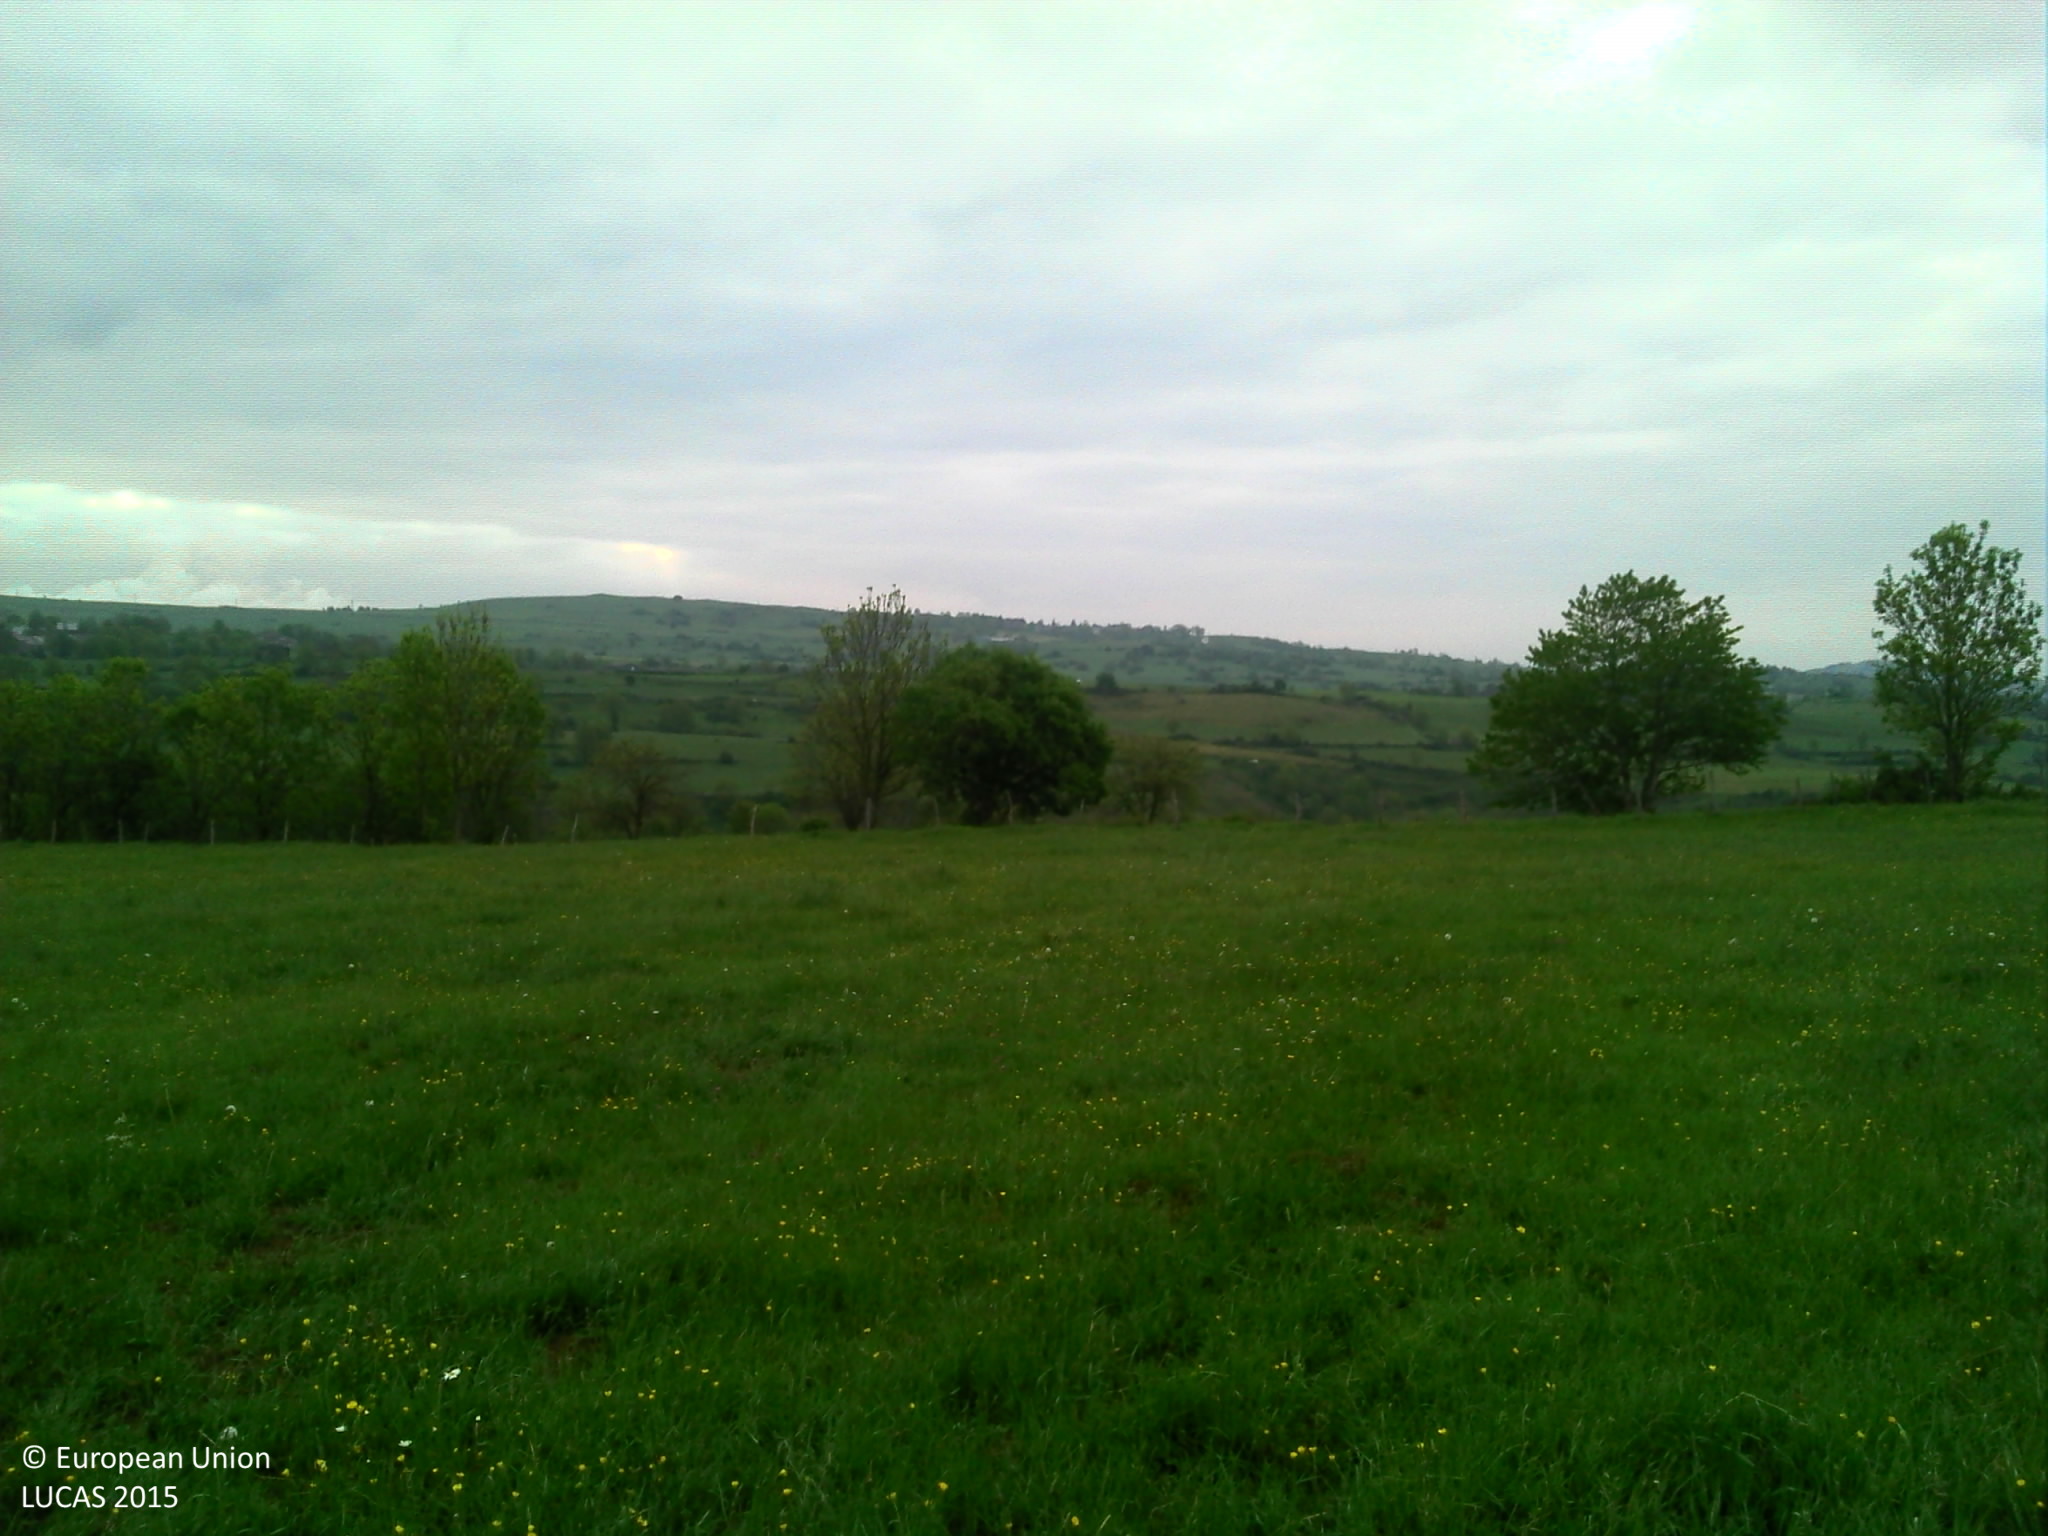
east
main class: Grassland
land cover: Grassland without tree/shrub cover
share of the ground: > 75 %
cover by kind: herbaceous plants 100 %
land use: Agriculture (excluding fallow land and kitchen gardens)
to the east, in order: Grassland without tree/shrub cover; Fences; Tracks; Lines of trees; Dry stone walls; Fences; Grassland without tree/shrub cover; Fences; Dry stone walls; Grassland without tree/shrub cover; Lines of trees; Grassland without tree/shrub cover; Electric lines; Tracks; Grassland without tree/shrub cover
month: May
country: FR
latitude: 45.1791
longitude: 2.9641
